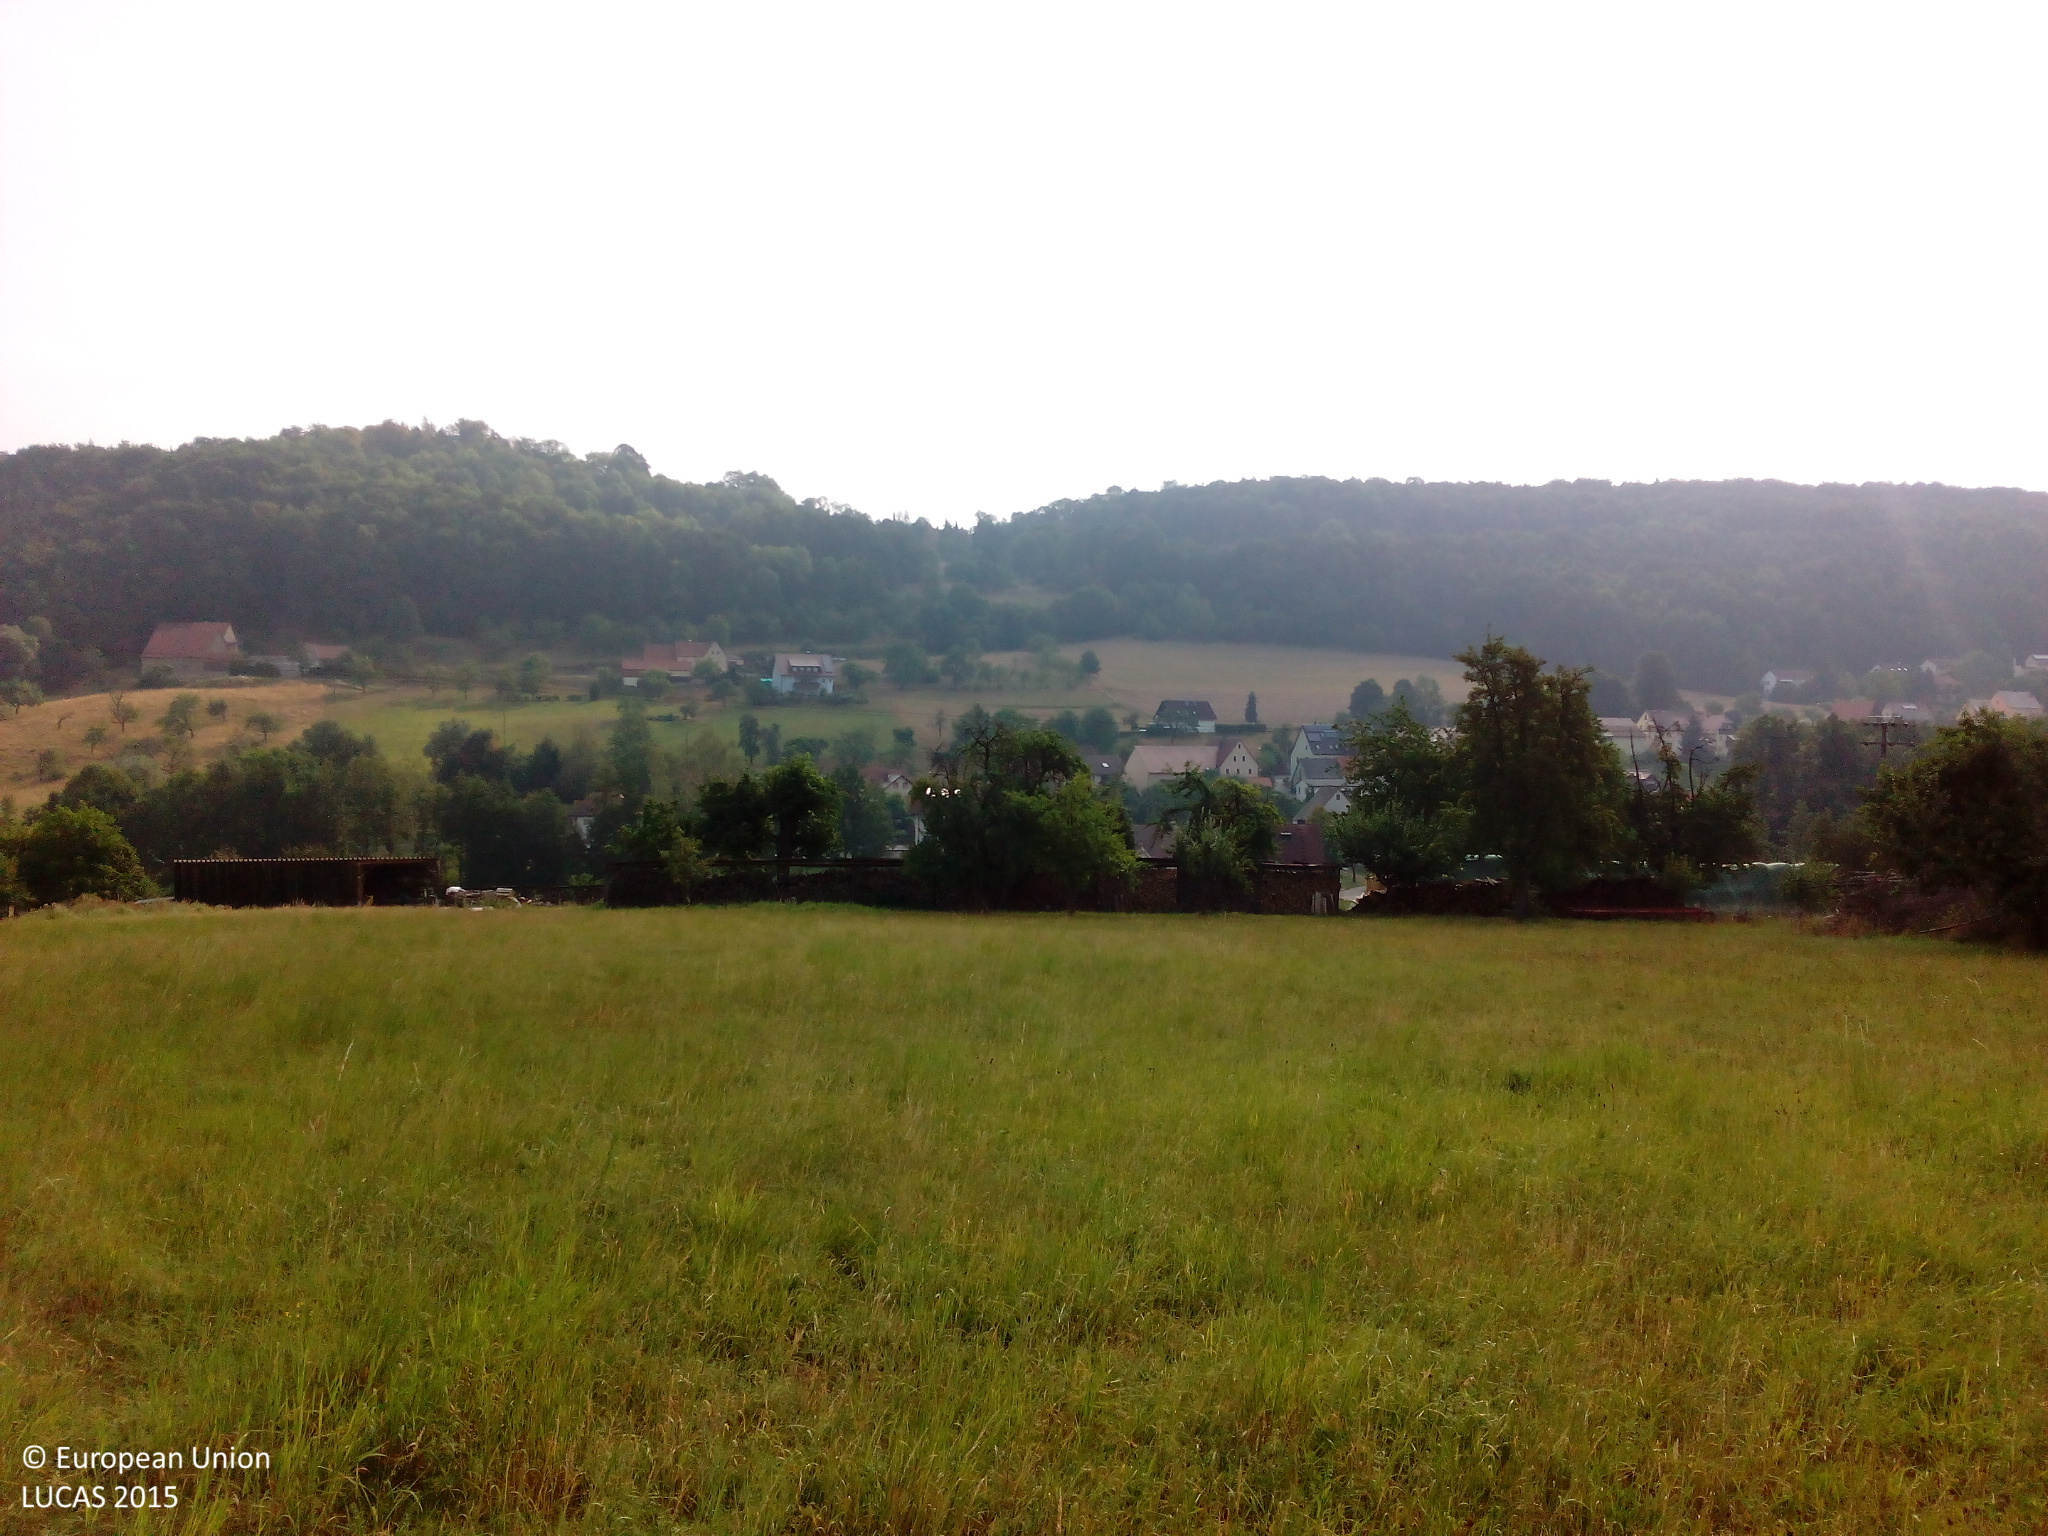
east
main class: Grassland
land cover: Grassland without tree/shrub cover
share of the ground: > 75 %
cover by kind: herbaceous plants 95 %
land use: Agriculture (excluding fallow land and kitchen gardens)
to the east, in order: Grassland without tree/shrub cover; Other fruit trees and berries; Grassland without tree/shrub cover; Apple fruit; Other structural elements; Apple fruit; Grassland without tree/shrub cover; Other structural elements; Electric lines; Grassland without tree/shrub cover; Tracks; Grassland without tree/shrub cover; Artificial constructions in urban areas; Abandoned hedges; Rivers and streams; Abandoned hedges; Grassland without tree/shrub cover
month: August
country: DE
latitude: 49.4732
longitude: 11.4762
